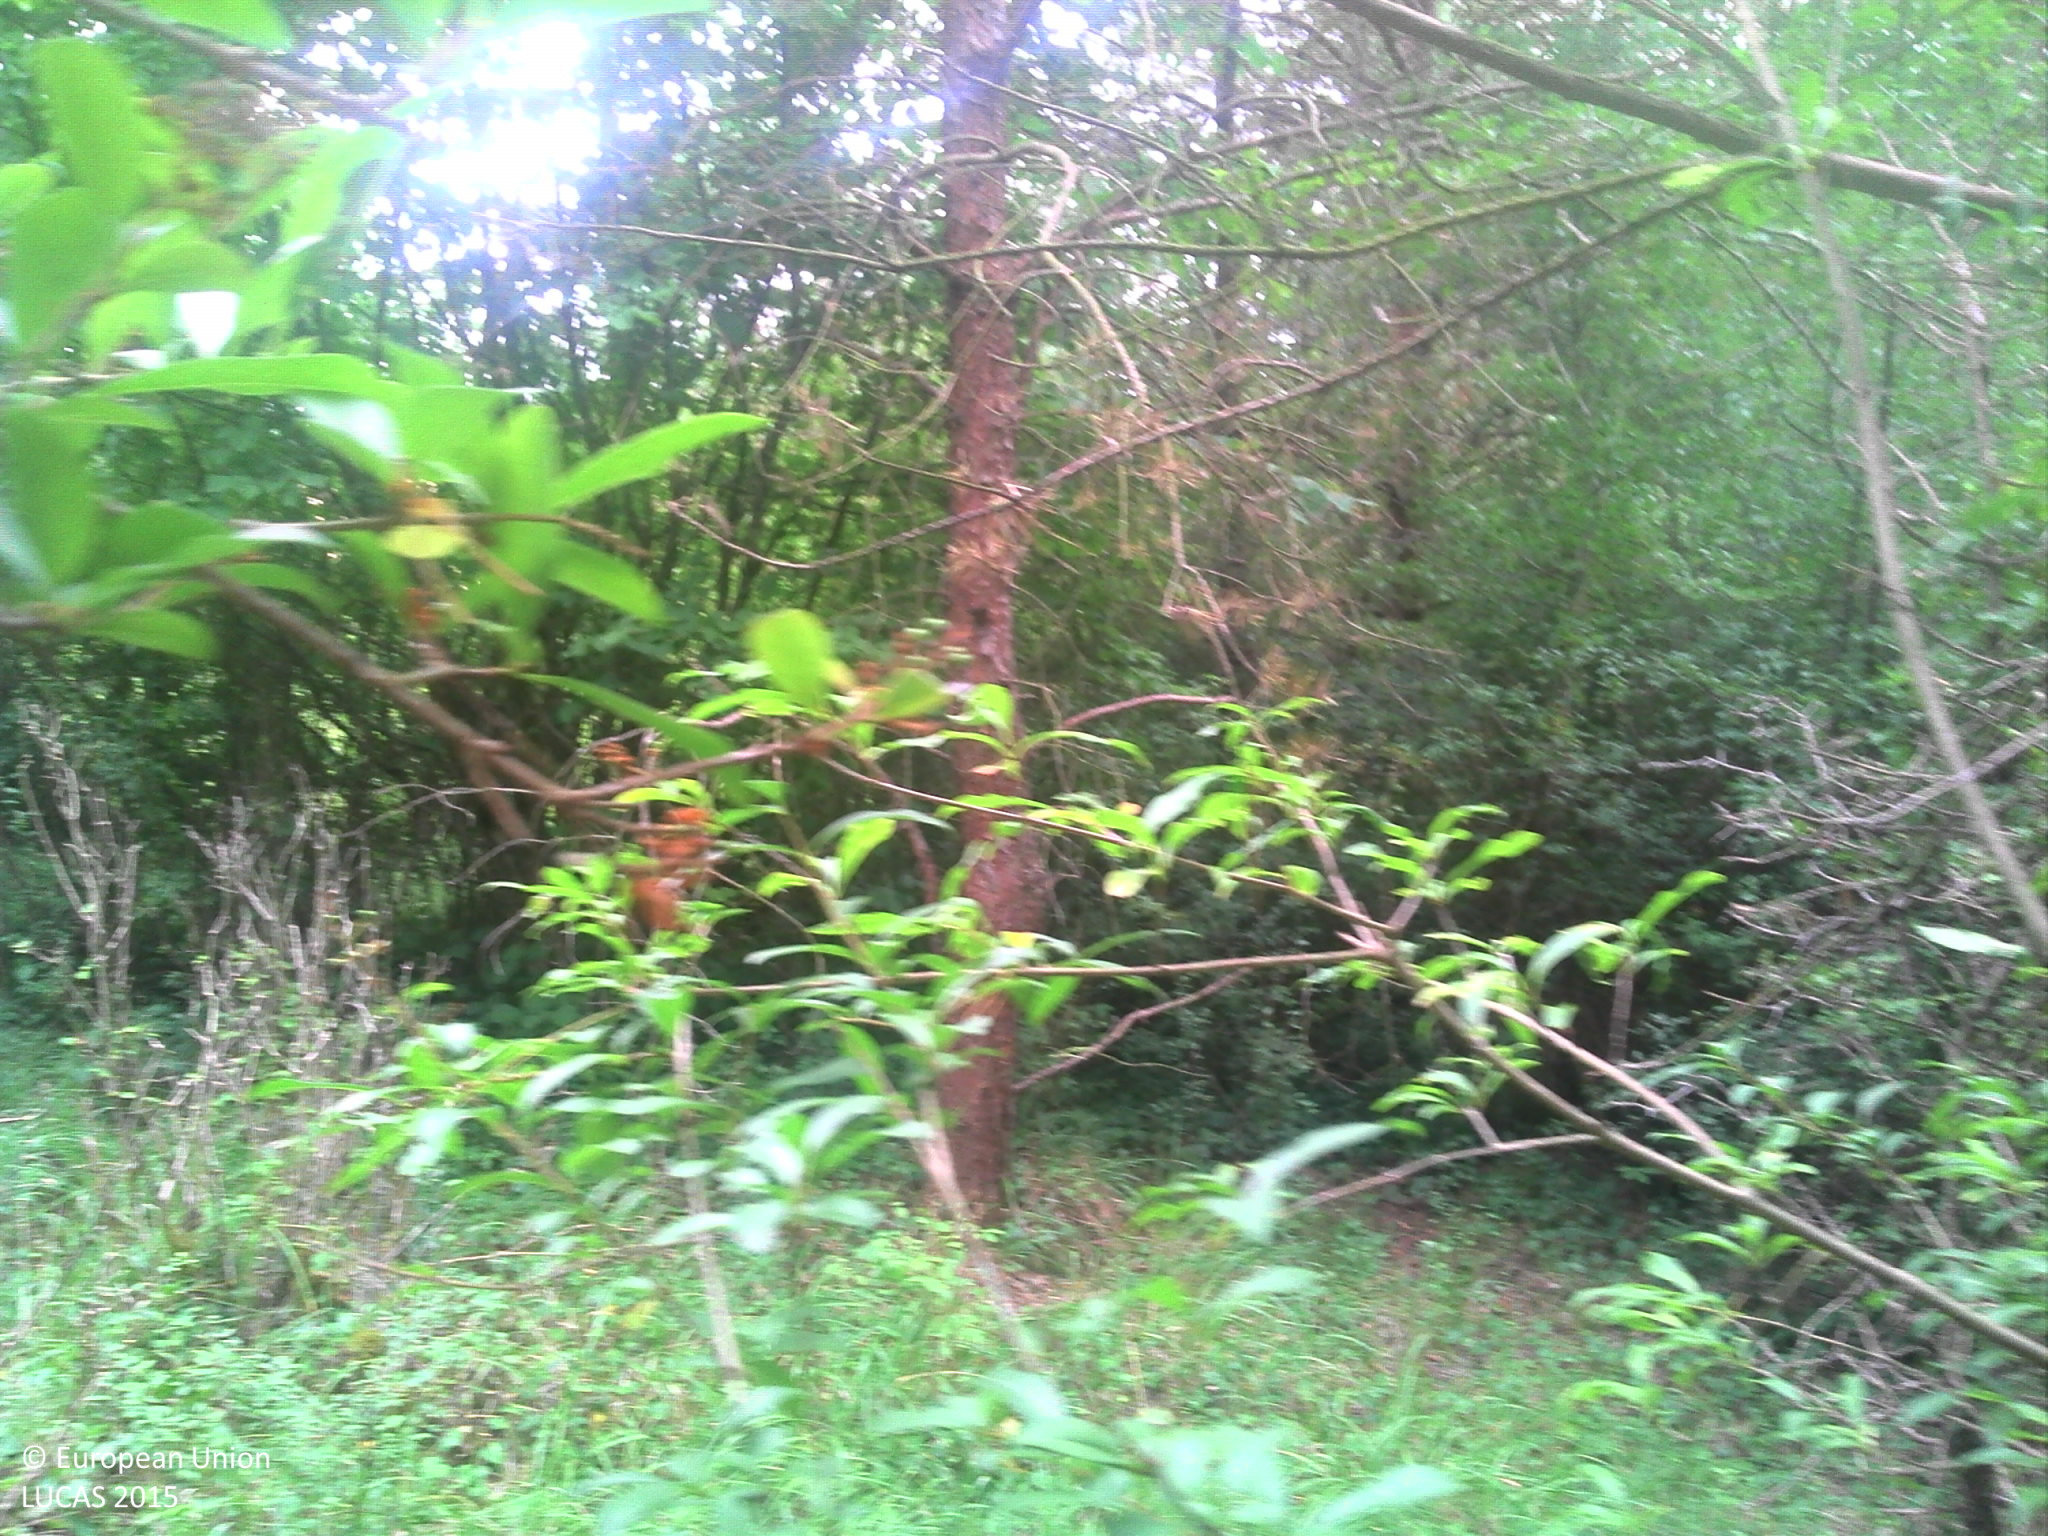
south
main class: Woodland
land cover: Broadleaved woodland
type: beech forest
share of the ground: > 75 %
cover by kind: broadleaved forest trees 70 %, coniferous forest trees 10 %, herbaceous plants 10 %, lichens and mosses 10 %
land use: Forestry
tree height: > 5 m
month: July
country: FR
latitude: 48.0068
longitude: 5.1068
